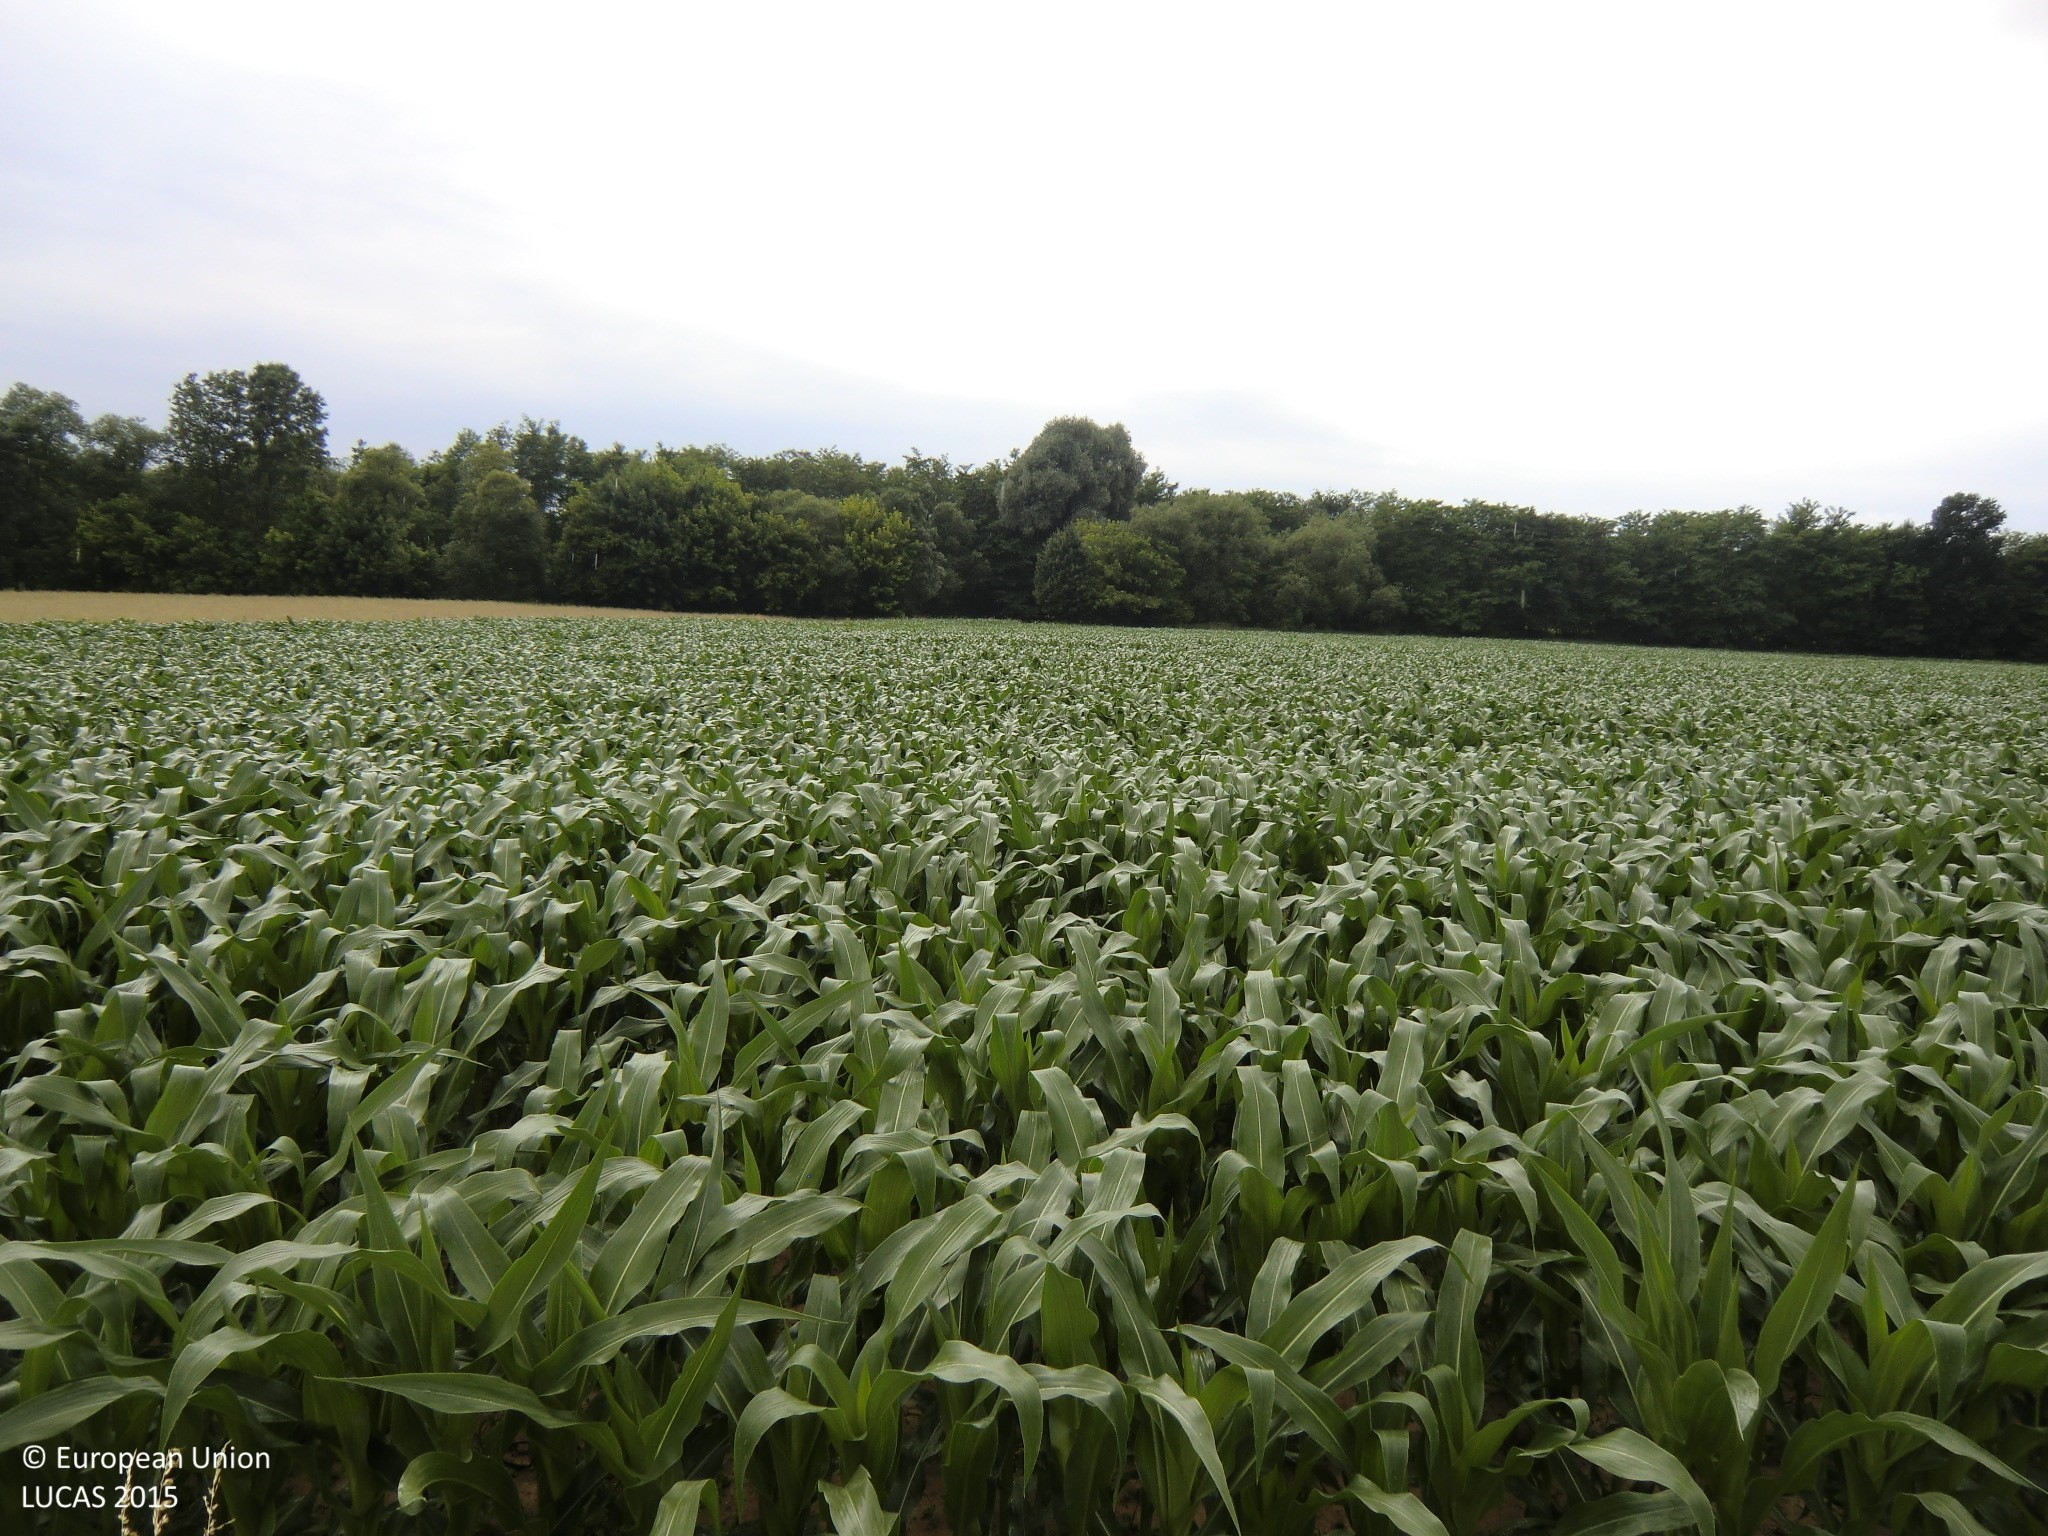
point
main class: Cropland
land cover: Maize
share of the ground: > 75 %
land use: Agriculture (excluding fallow land and kitchen gardens)
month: June
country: AT
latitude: 47.1697
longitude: 16.1100
